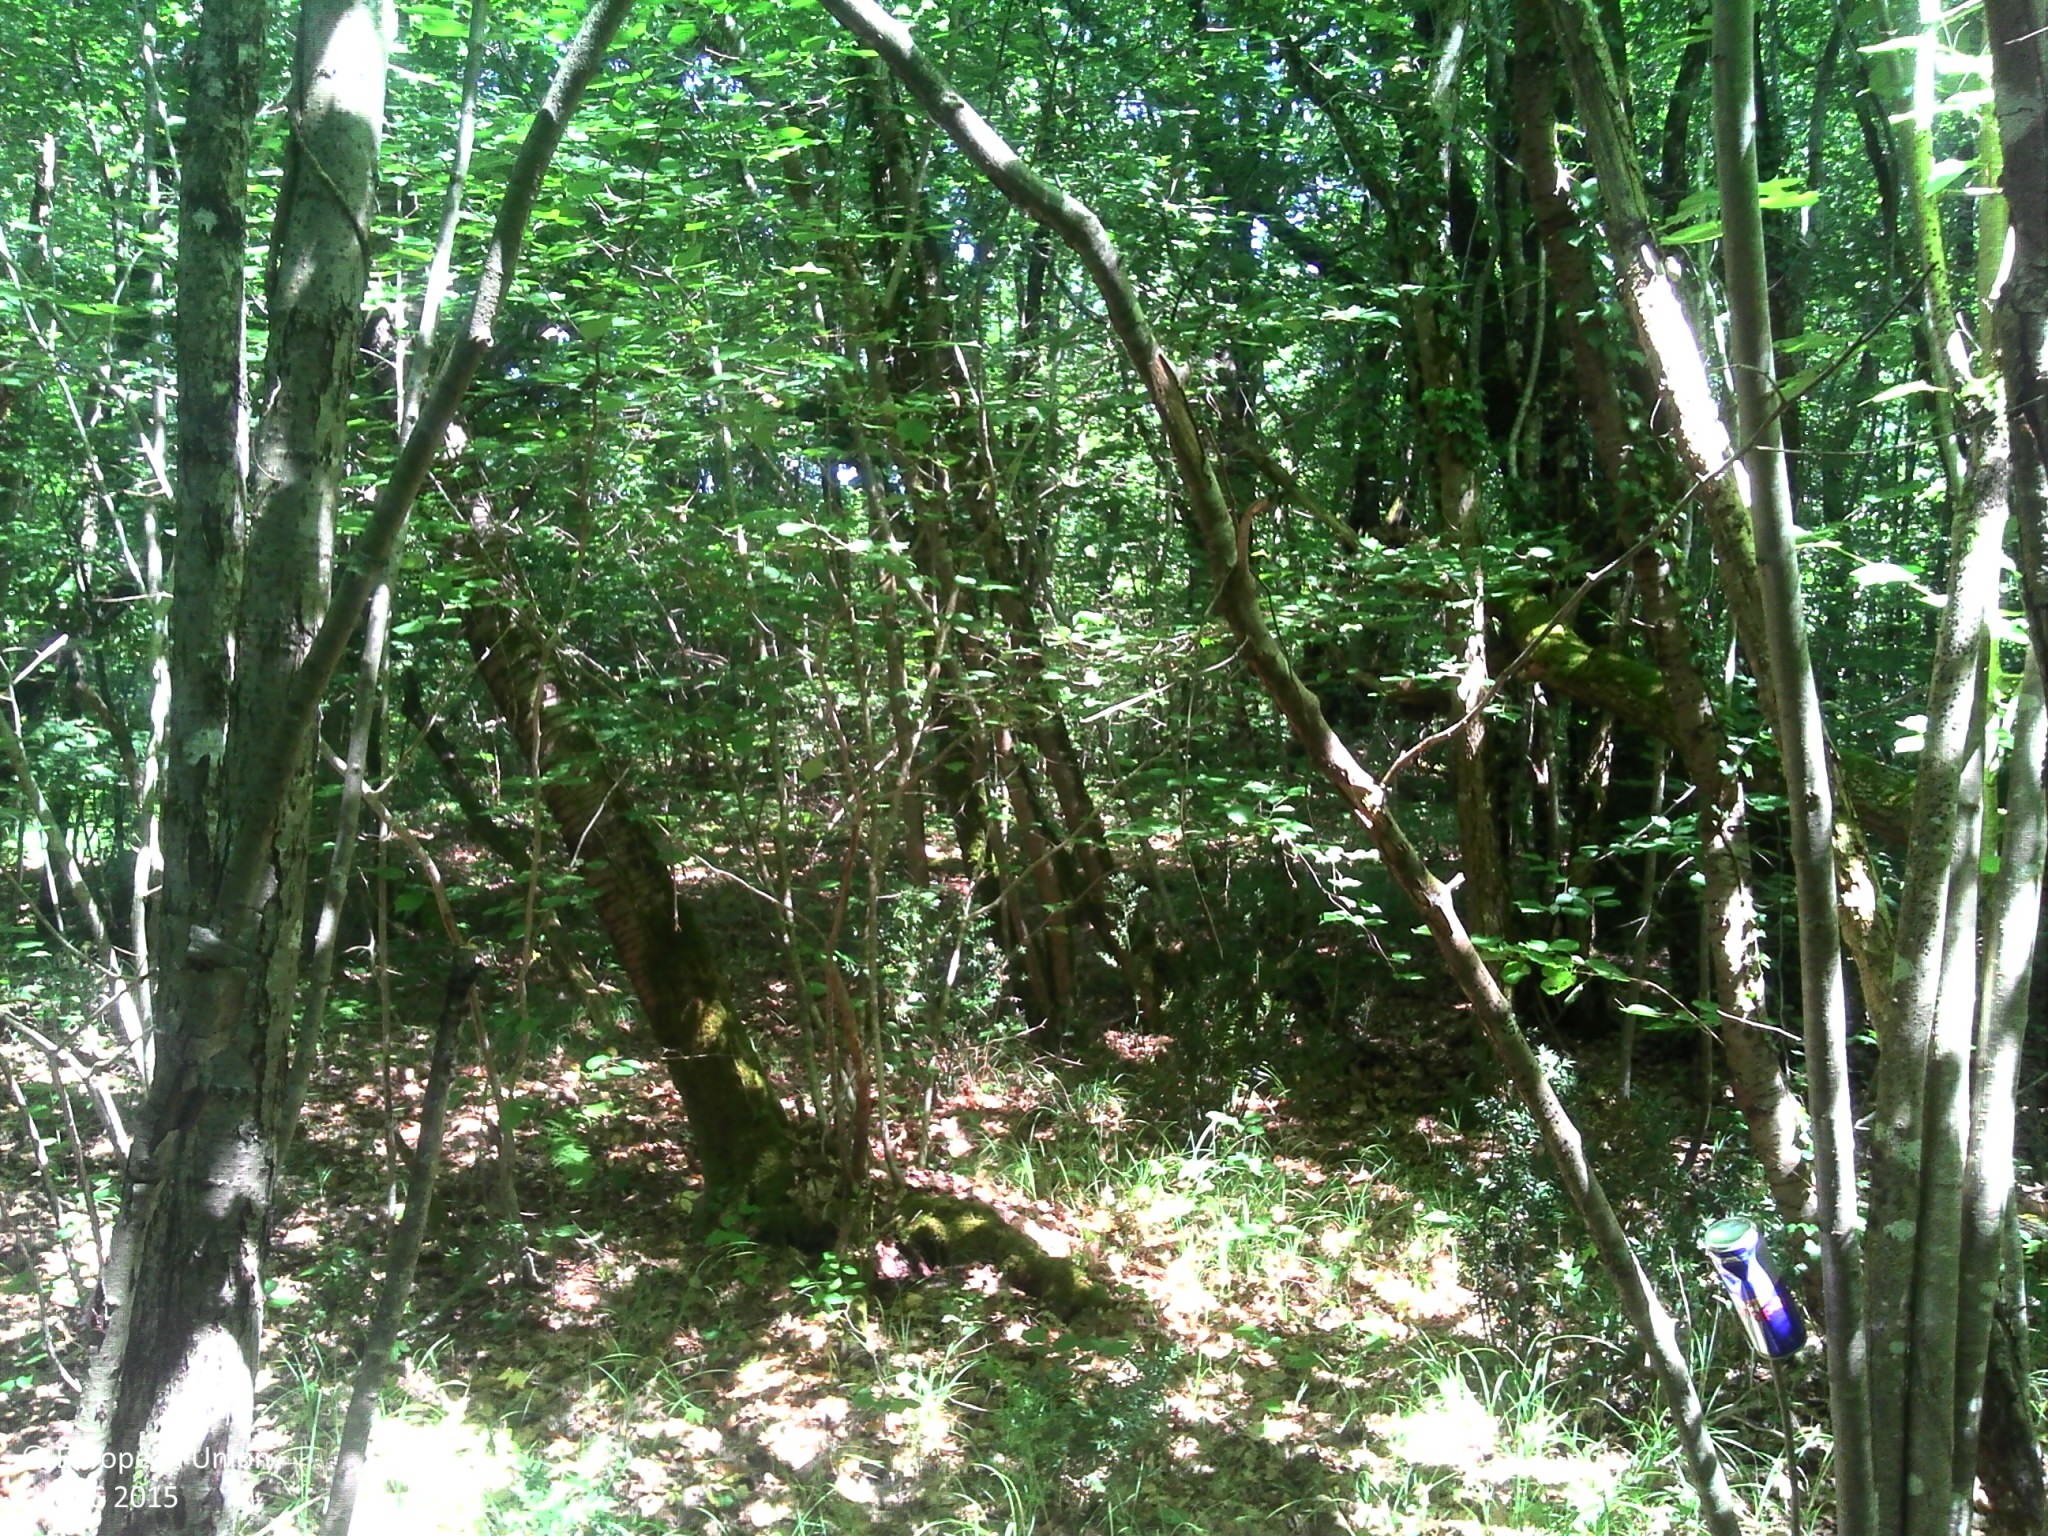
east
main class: Woodland
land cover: Broadleaved woodland
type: mesophytic deciduous forest
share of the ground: > 75 %
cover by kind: broadleaved forest trees 100 %
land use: Forestry
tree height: > 5 m
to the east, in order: Broadleaved woodland; Tracks; Broadleaved woodland; Grass margins; Paved roads, cycling and walking lanes; Grass margins; Fences; Broadleaved woodland; Grass margins; Fences; Grass margins; Paved roads, cycling and walking lanes; Grass margins; Fences; Grass margins; Fences; Broadleaved woodland; Grass margins; Paved roads, cycling and walking lanes; Grass margins; Broadleaved woodland
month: June
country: FR
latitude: 45.6558
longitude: -0.6367
